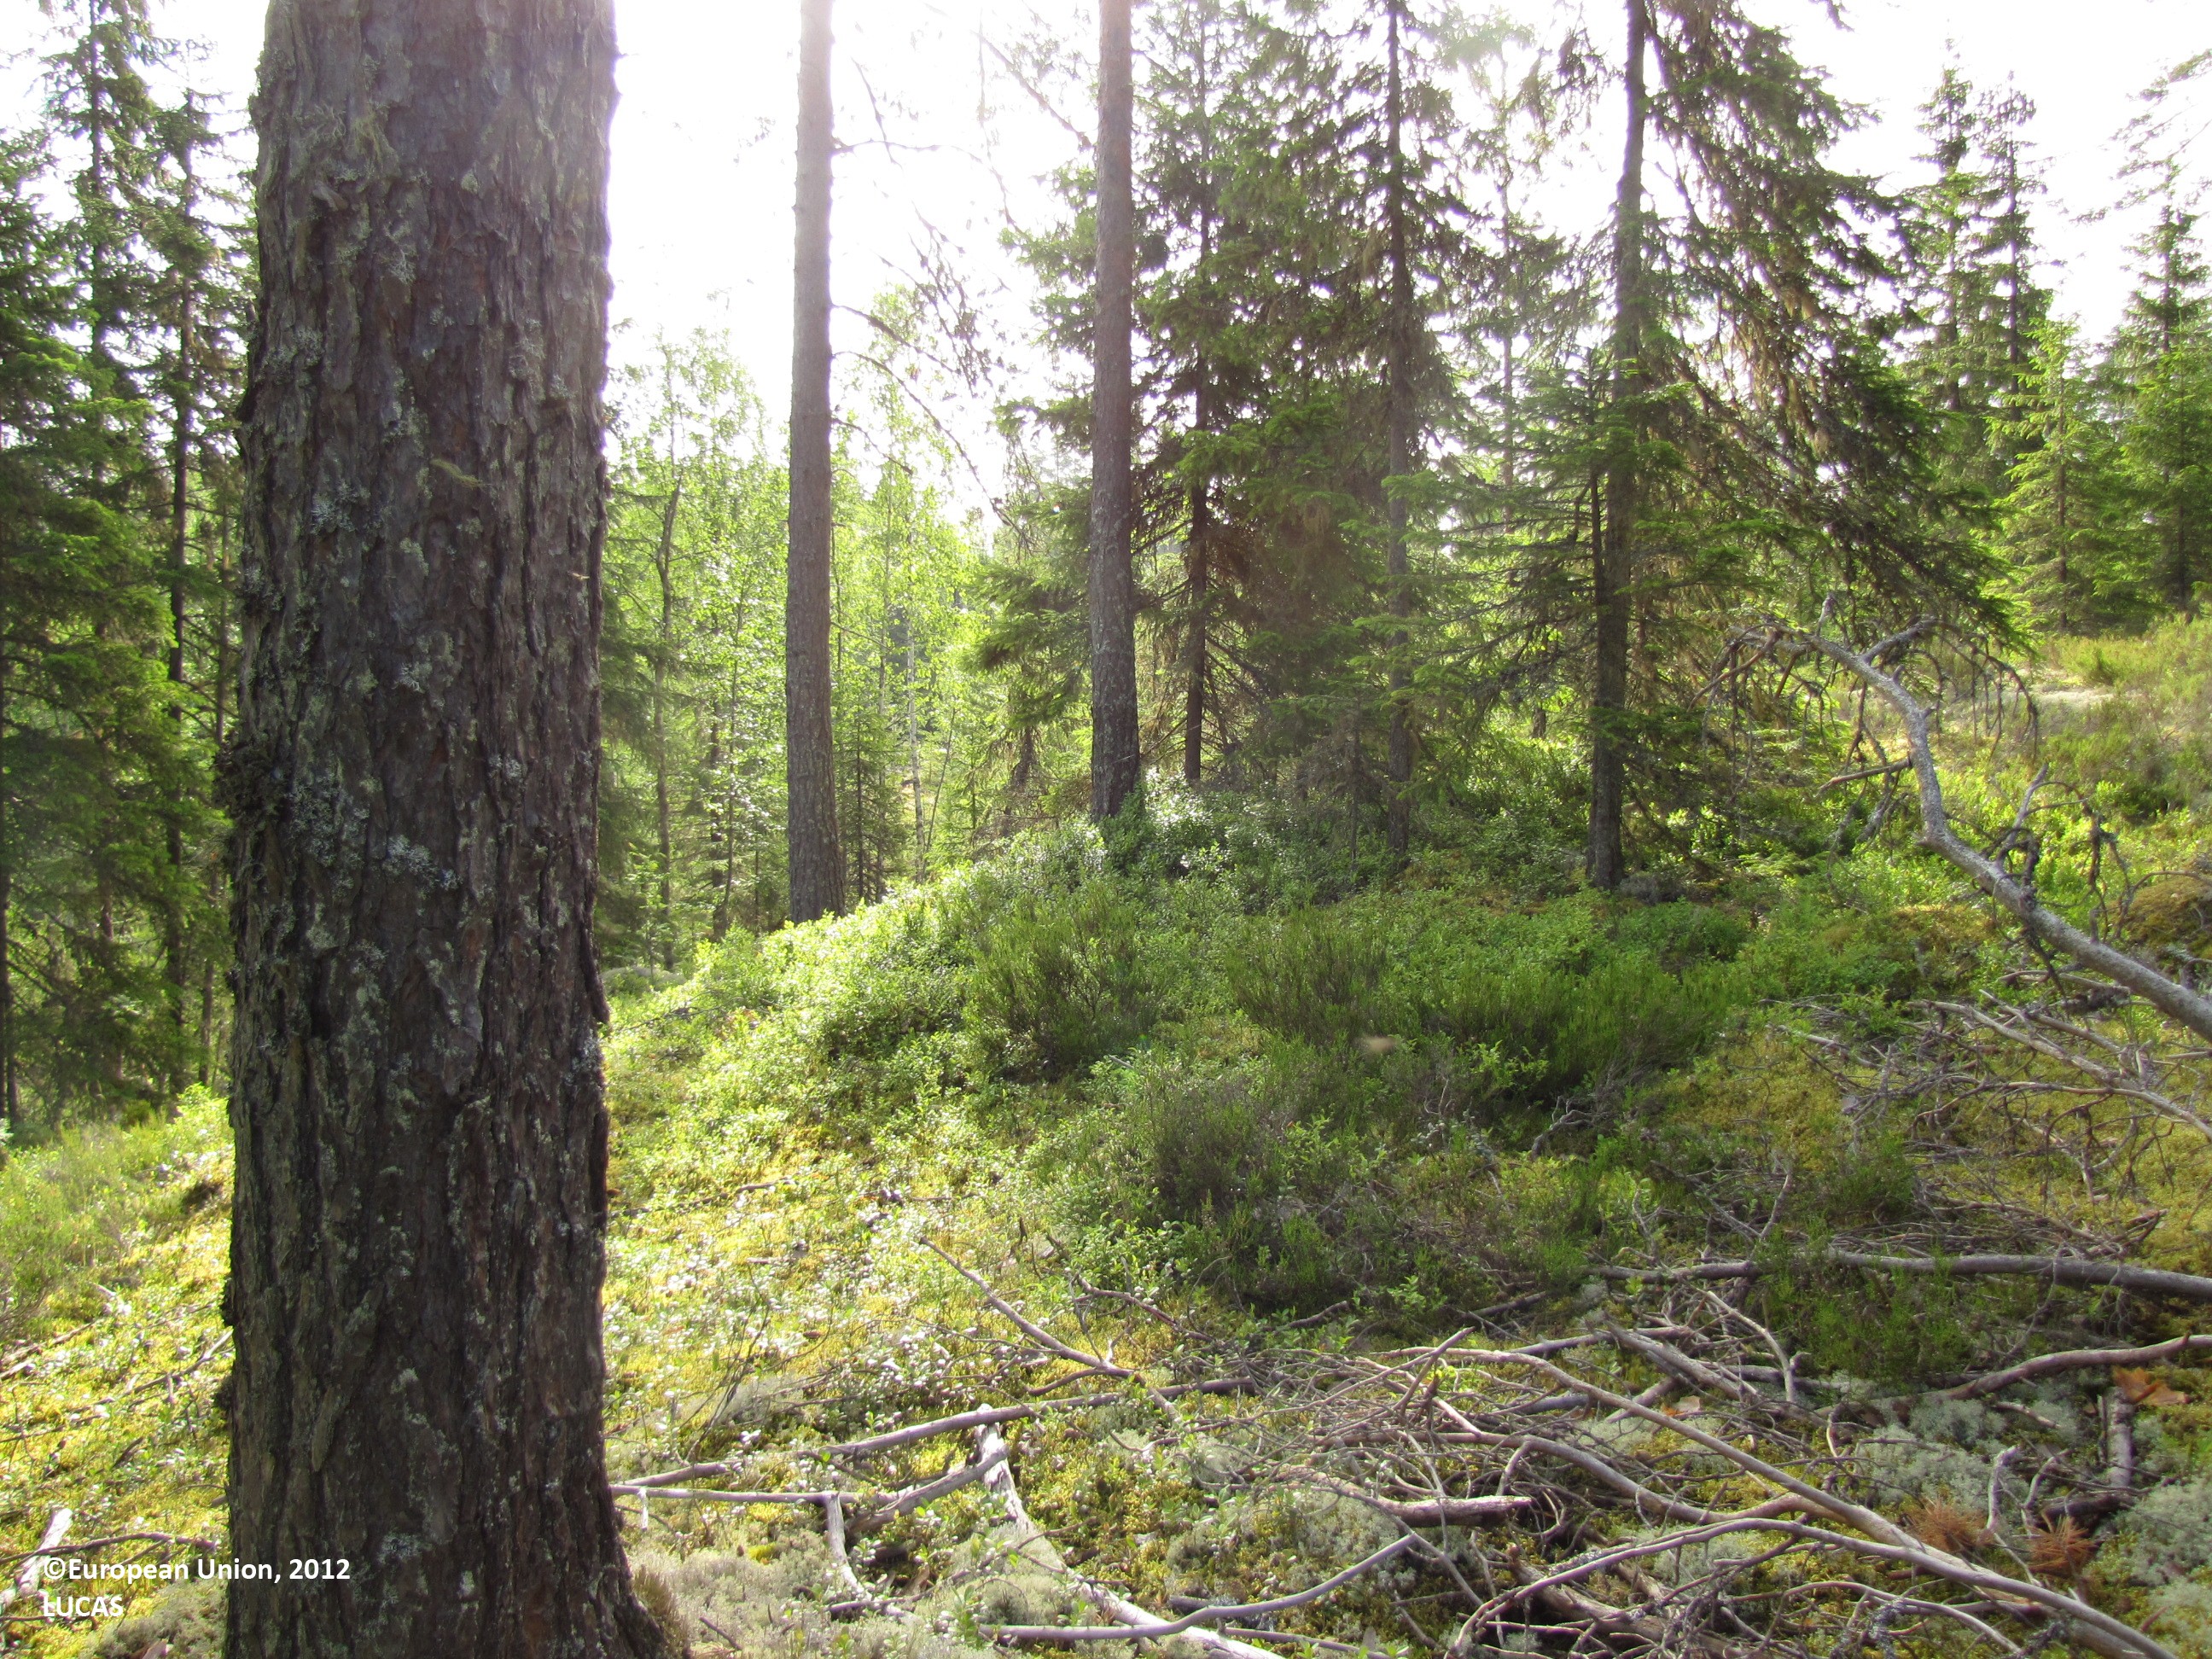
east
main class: Woodland
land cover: Pine dominated coniferous woodland
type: boreal forest
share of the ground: 50 - 75 %
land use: Forestry
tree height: > 5 m
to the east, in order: Pine dominated coniferous woodland; Spruce dominated coniferous woodland; Pine dominated coniferous woodland; Spruce dominated coniferous woodland; Broadleaved woodland; Spruce dominated coniferous woodland
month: June
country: FI
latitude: 61.7180
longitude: 24.5327
